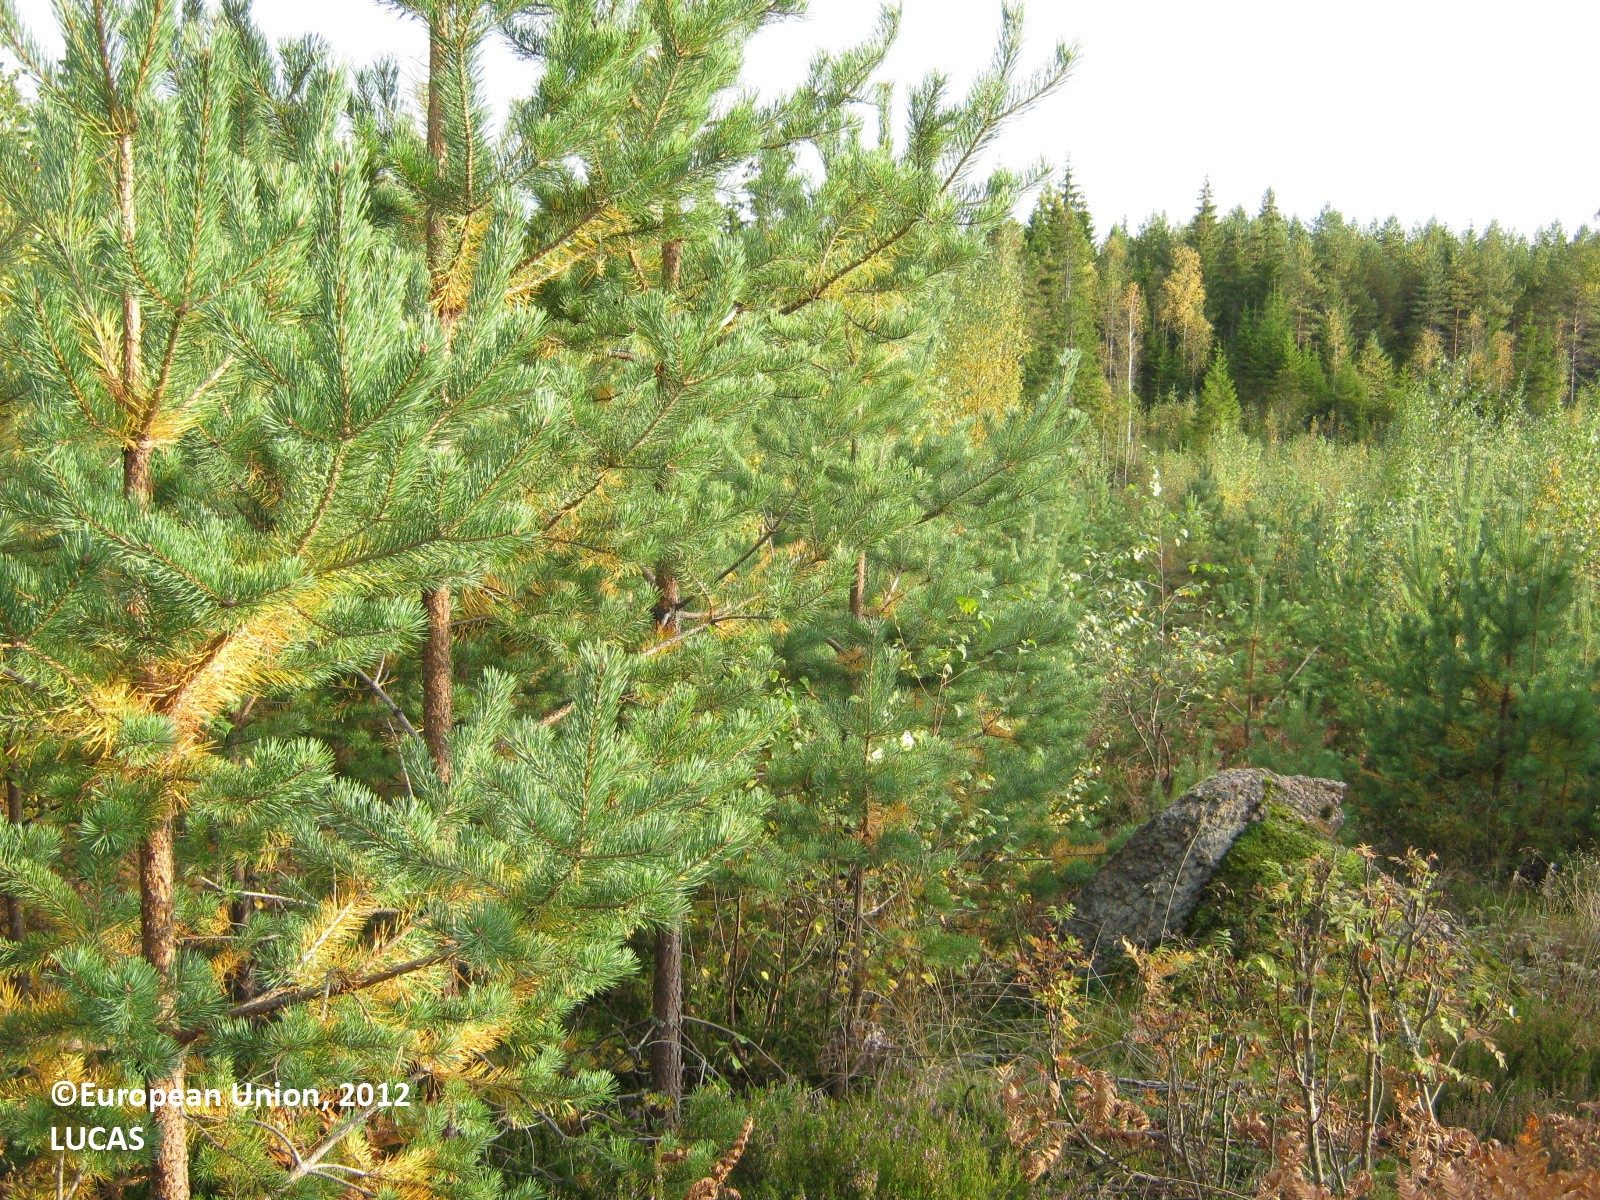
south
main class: Woodland
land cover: Pine dominated mixed woodland
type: boreal forest
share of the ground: > 75 %
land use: Forestry
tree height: < 5 m
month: September
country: FI
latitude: 60.7975
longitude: 27.7772
